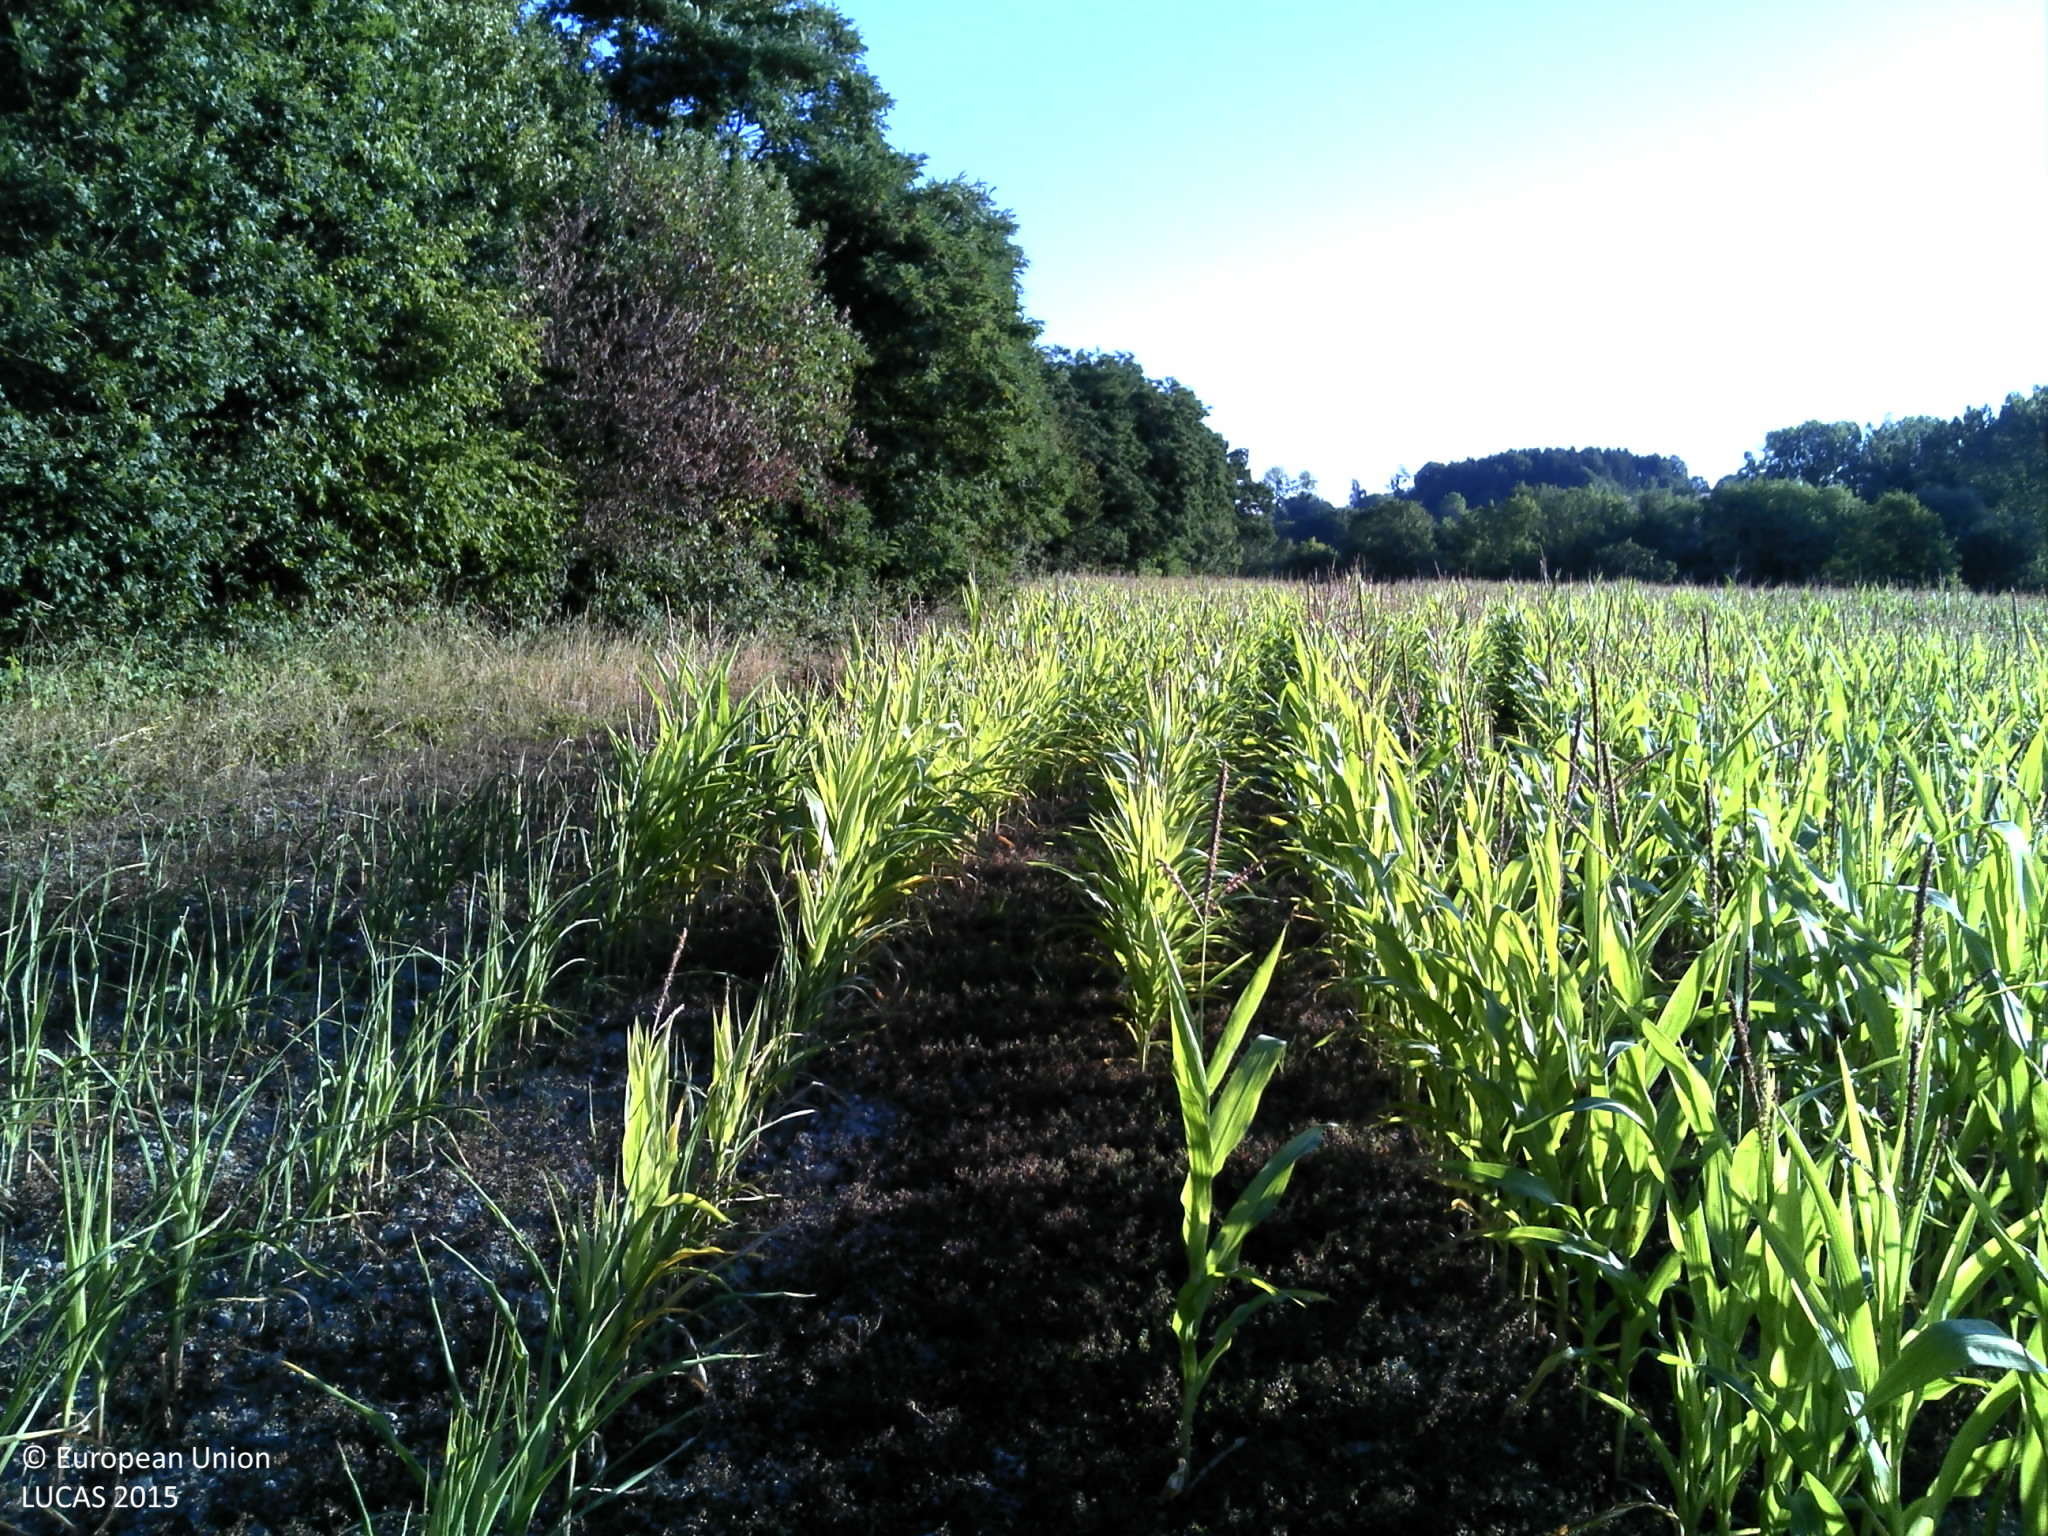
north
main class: Cropland
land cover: Maize
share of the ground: 50 - 75 %
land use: Agriculture (excluding fallow land and kitchen gardens)
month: August
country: FR
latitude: 49.1132
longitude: 4.8600
